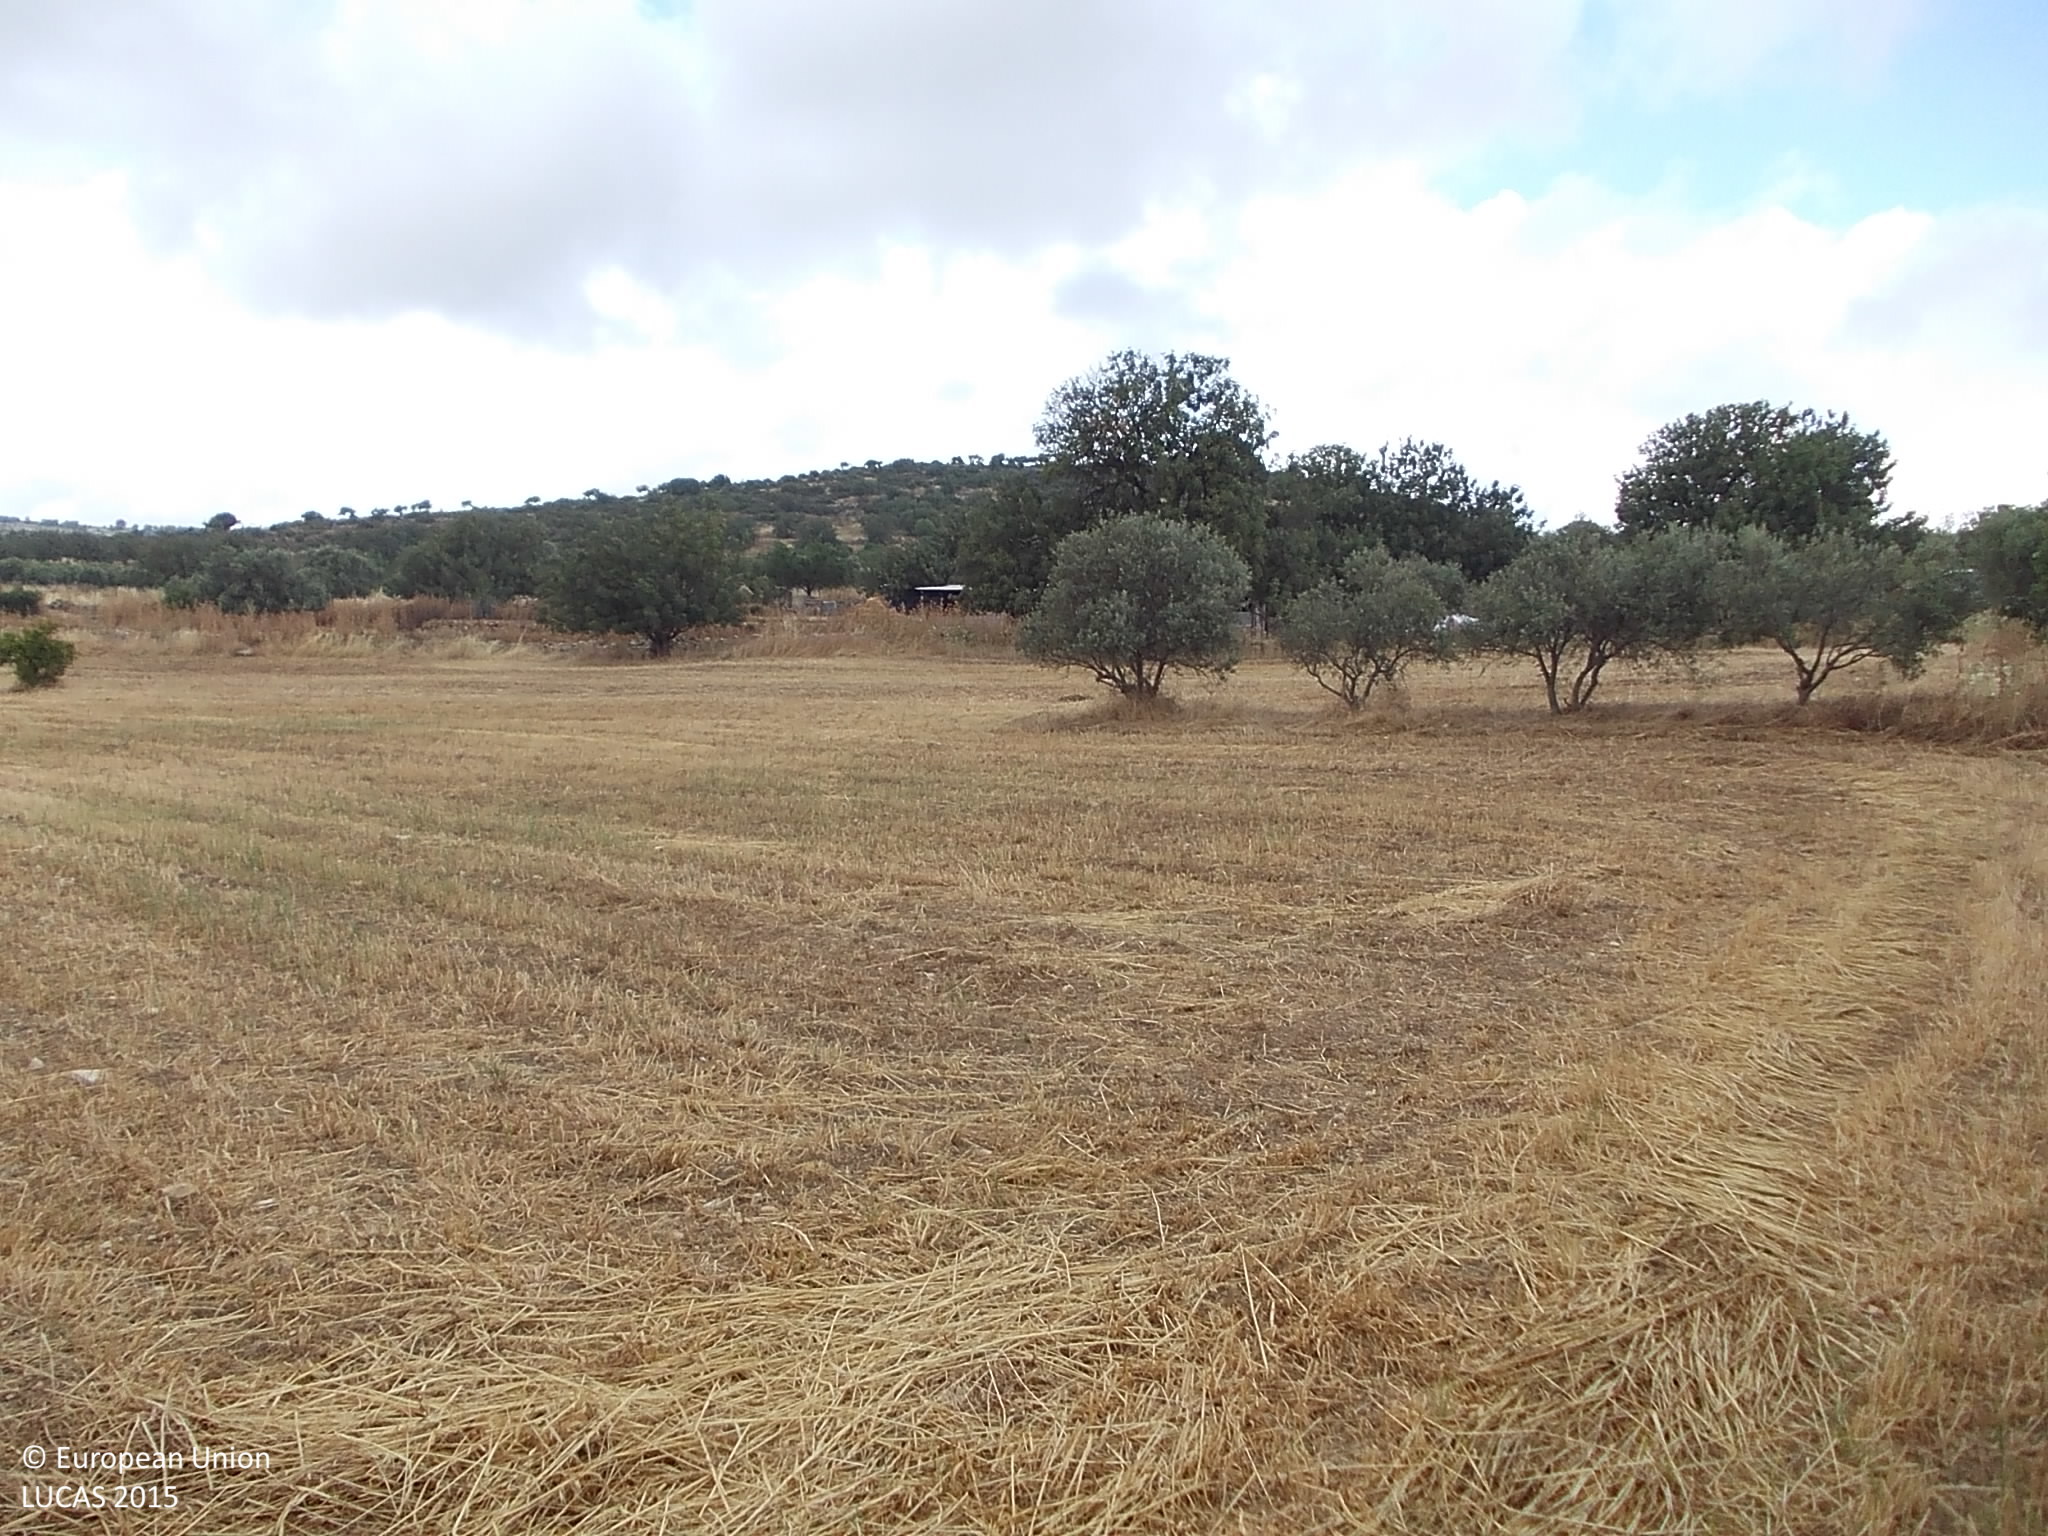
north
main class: Cropland
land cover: Olive groves
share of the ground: 10 - 25 %
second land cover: Other bare soil
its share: > 75 %
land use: Agriculture (excluding fallow land and kitchen gardens)
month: May
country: CY
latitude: 34.7558
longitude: 32.7818
